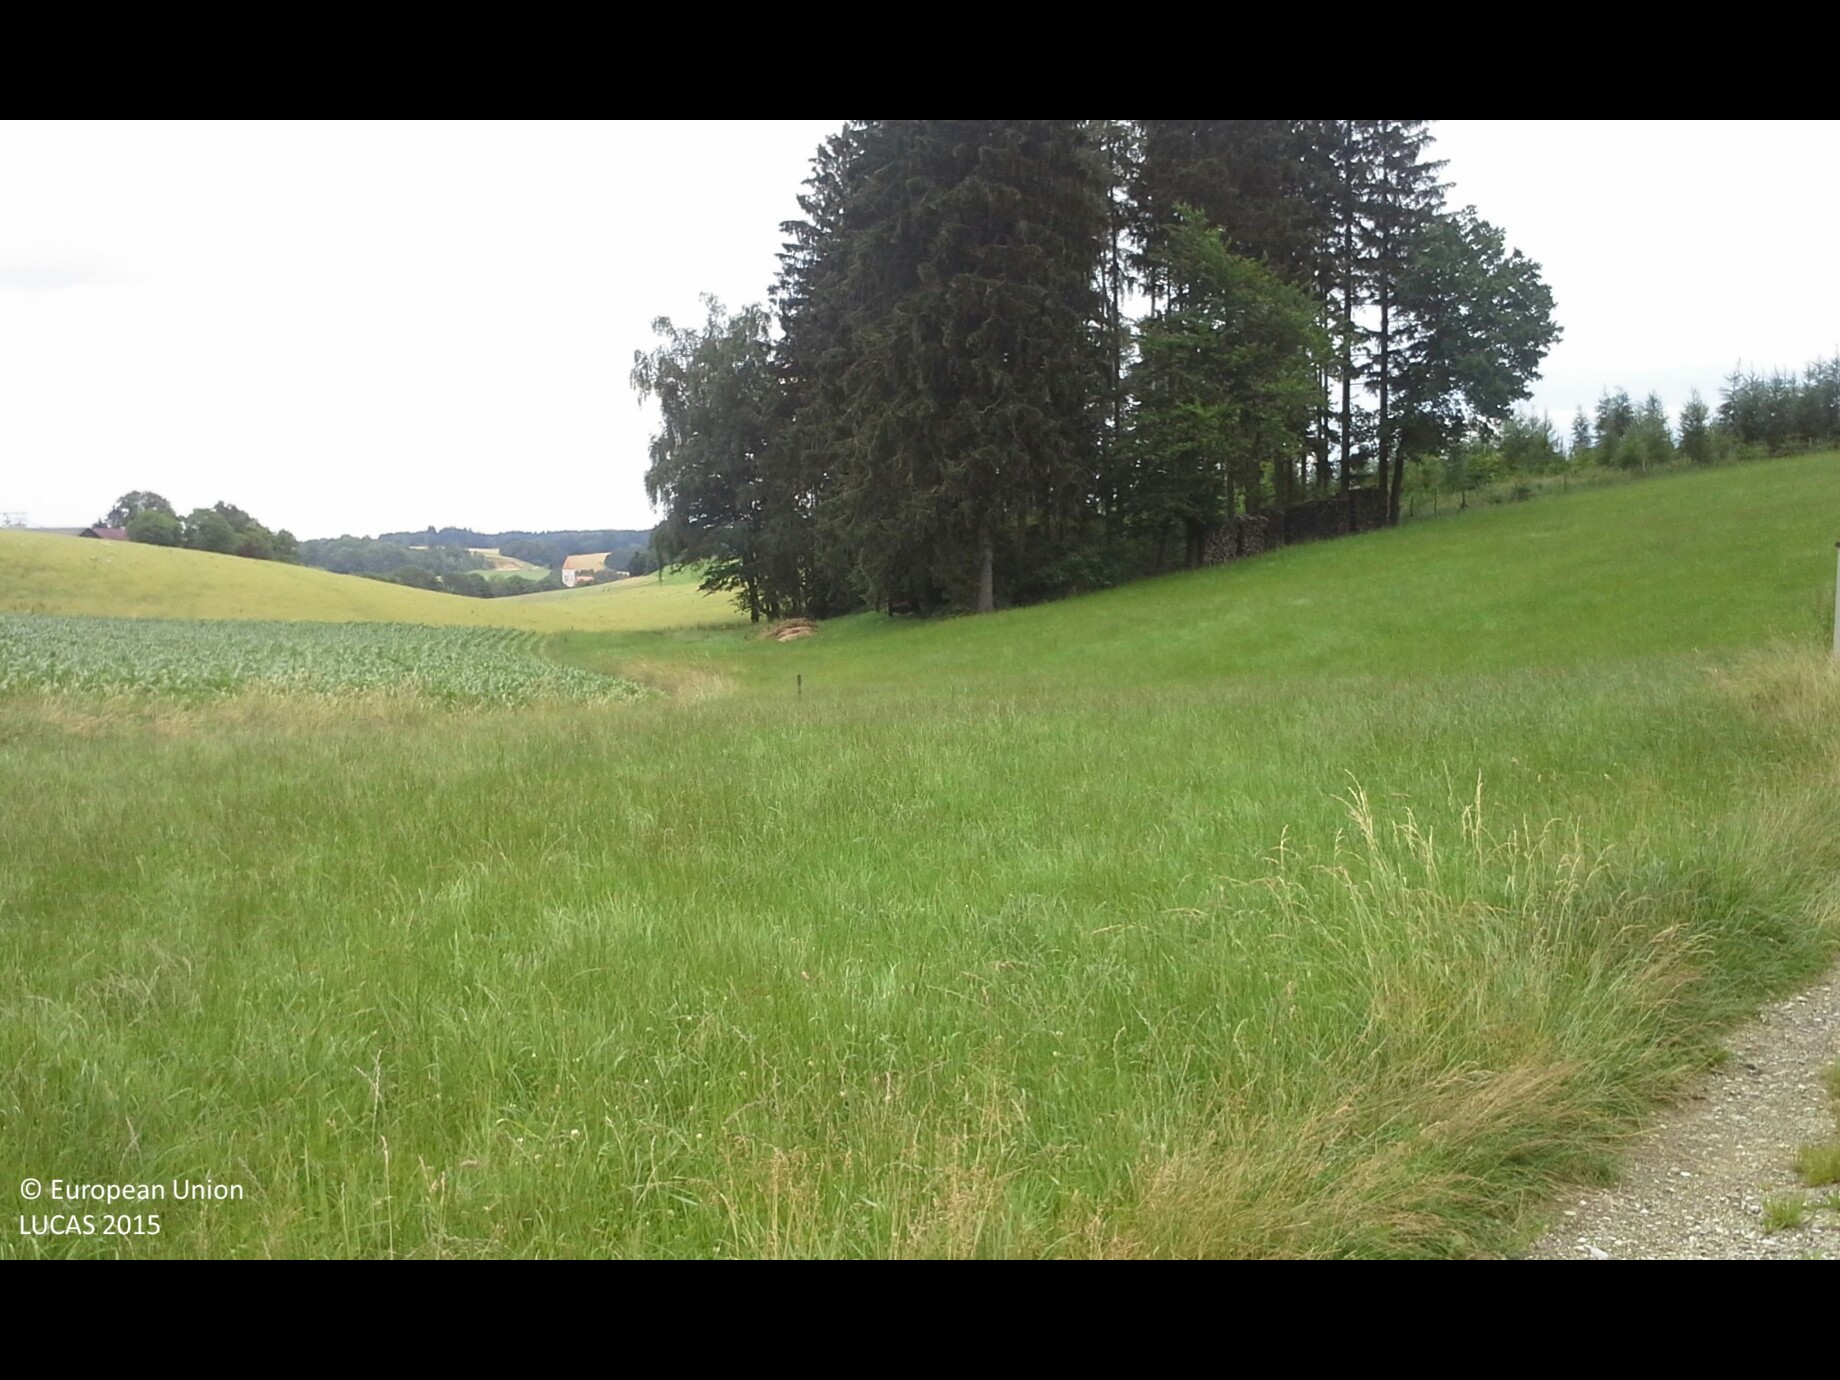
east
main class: Cropland
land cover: Triticale
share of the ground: > 75 %
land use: Agriculture (excluding fallow land and kitchen gardens)
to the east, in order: Triticale; Grass margins; Tracks; Grassland without tree/shrub cover; Spruce dominated coniferous woodland; Groves; Grass margins; Rape and turnip rape
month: June
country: AT
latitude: 48.0778
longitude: 14.4967
